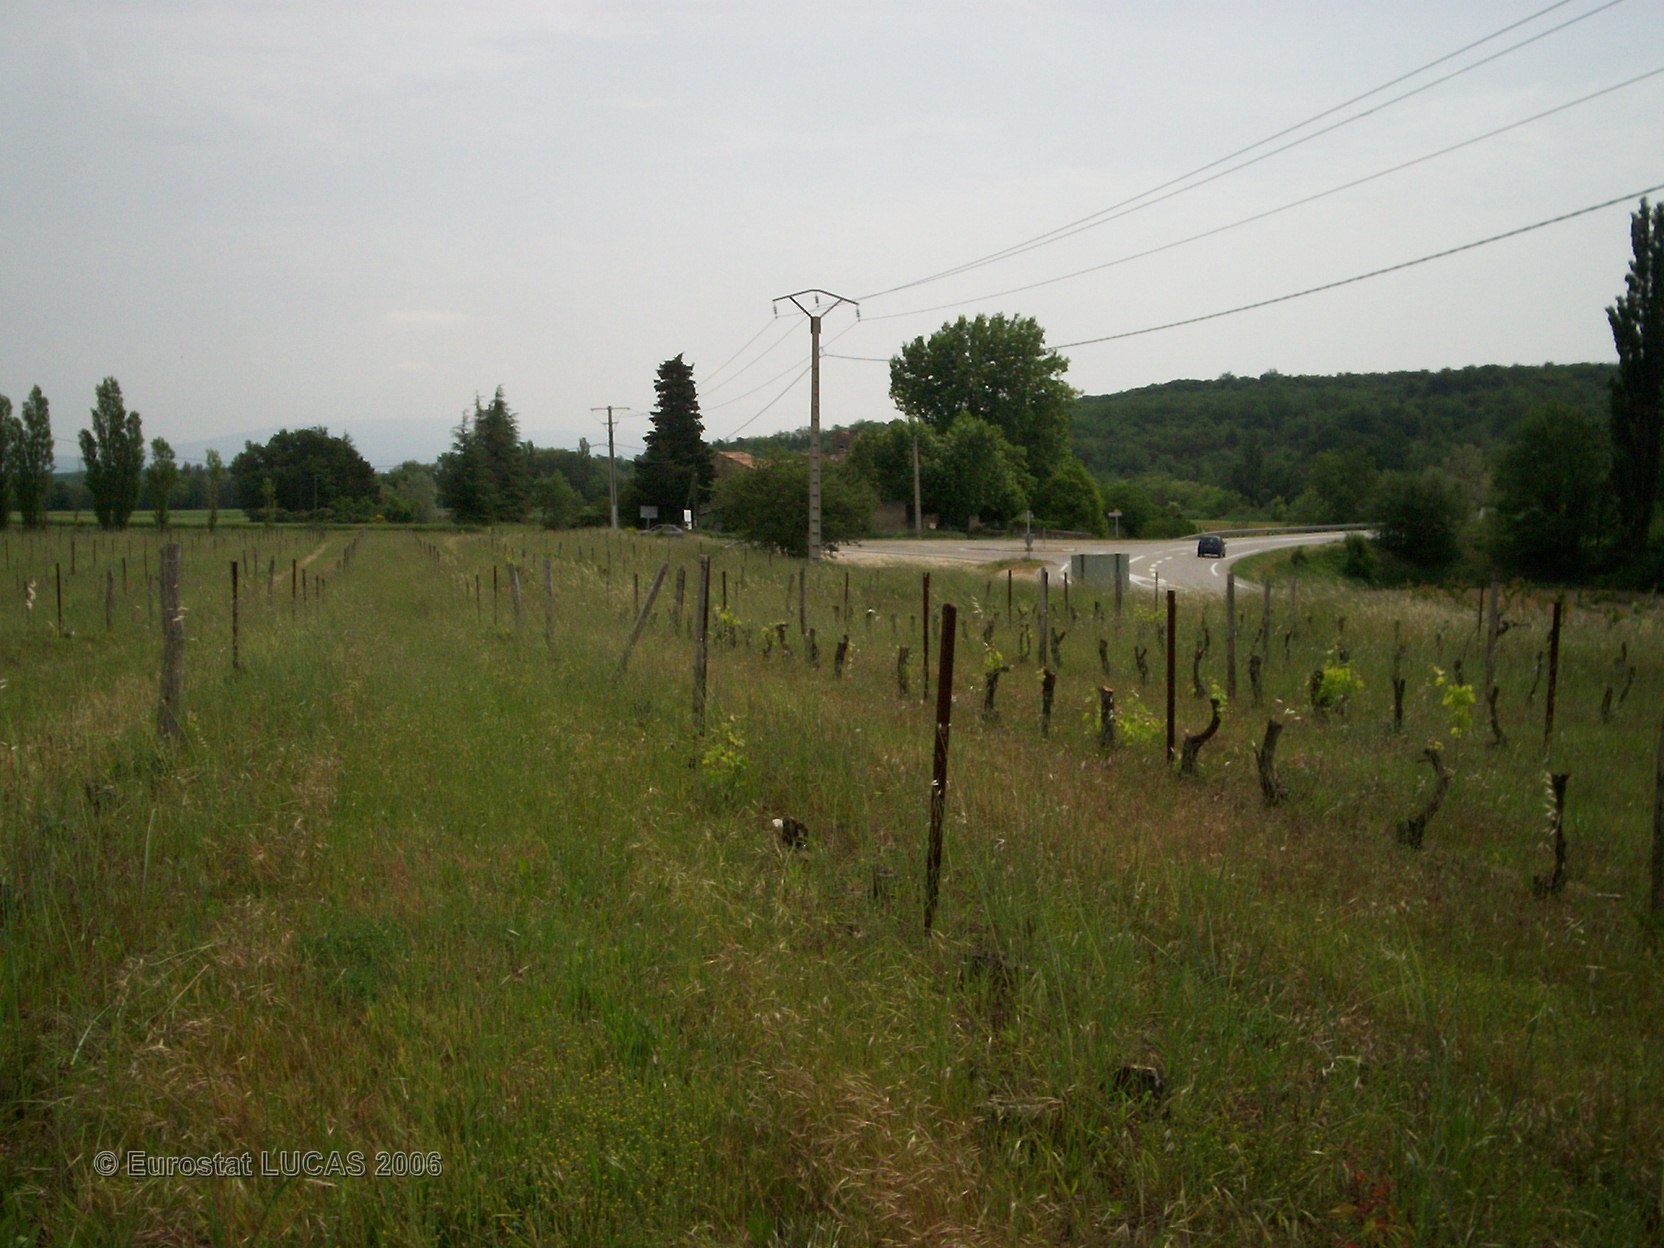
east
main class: Cropland
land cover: Vineyards
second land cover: Grassland with sparse tree/shrub cover
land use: Agriculture (excluding fallow land and kitchen gardens)
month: May
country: FR
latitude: 44.4212
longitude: 4.8450
